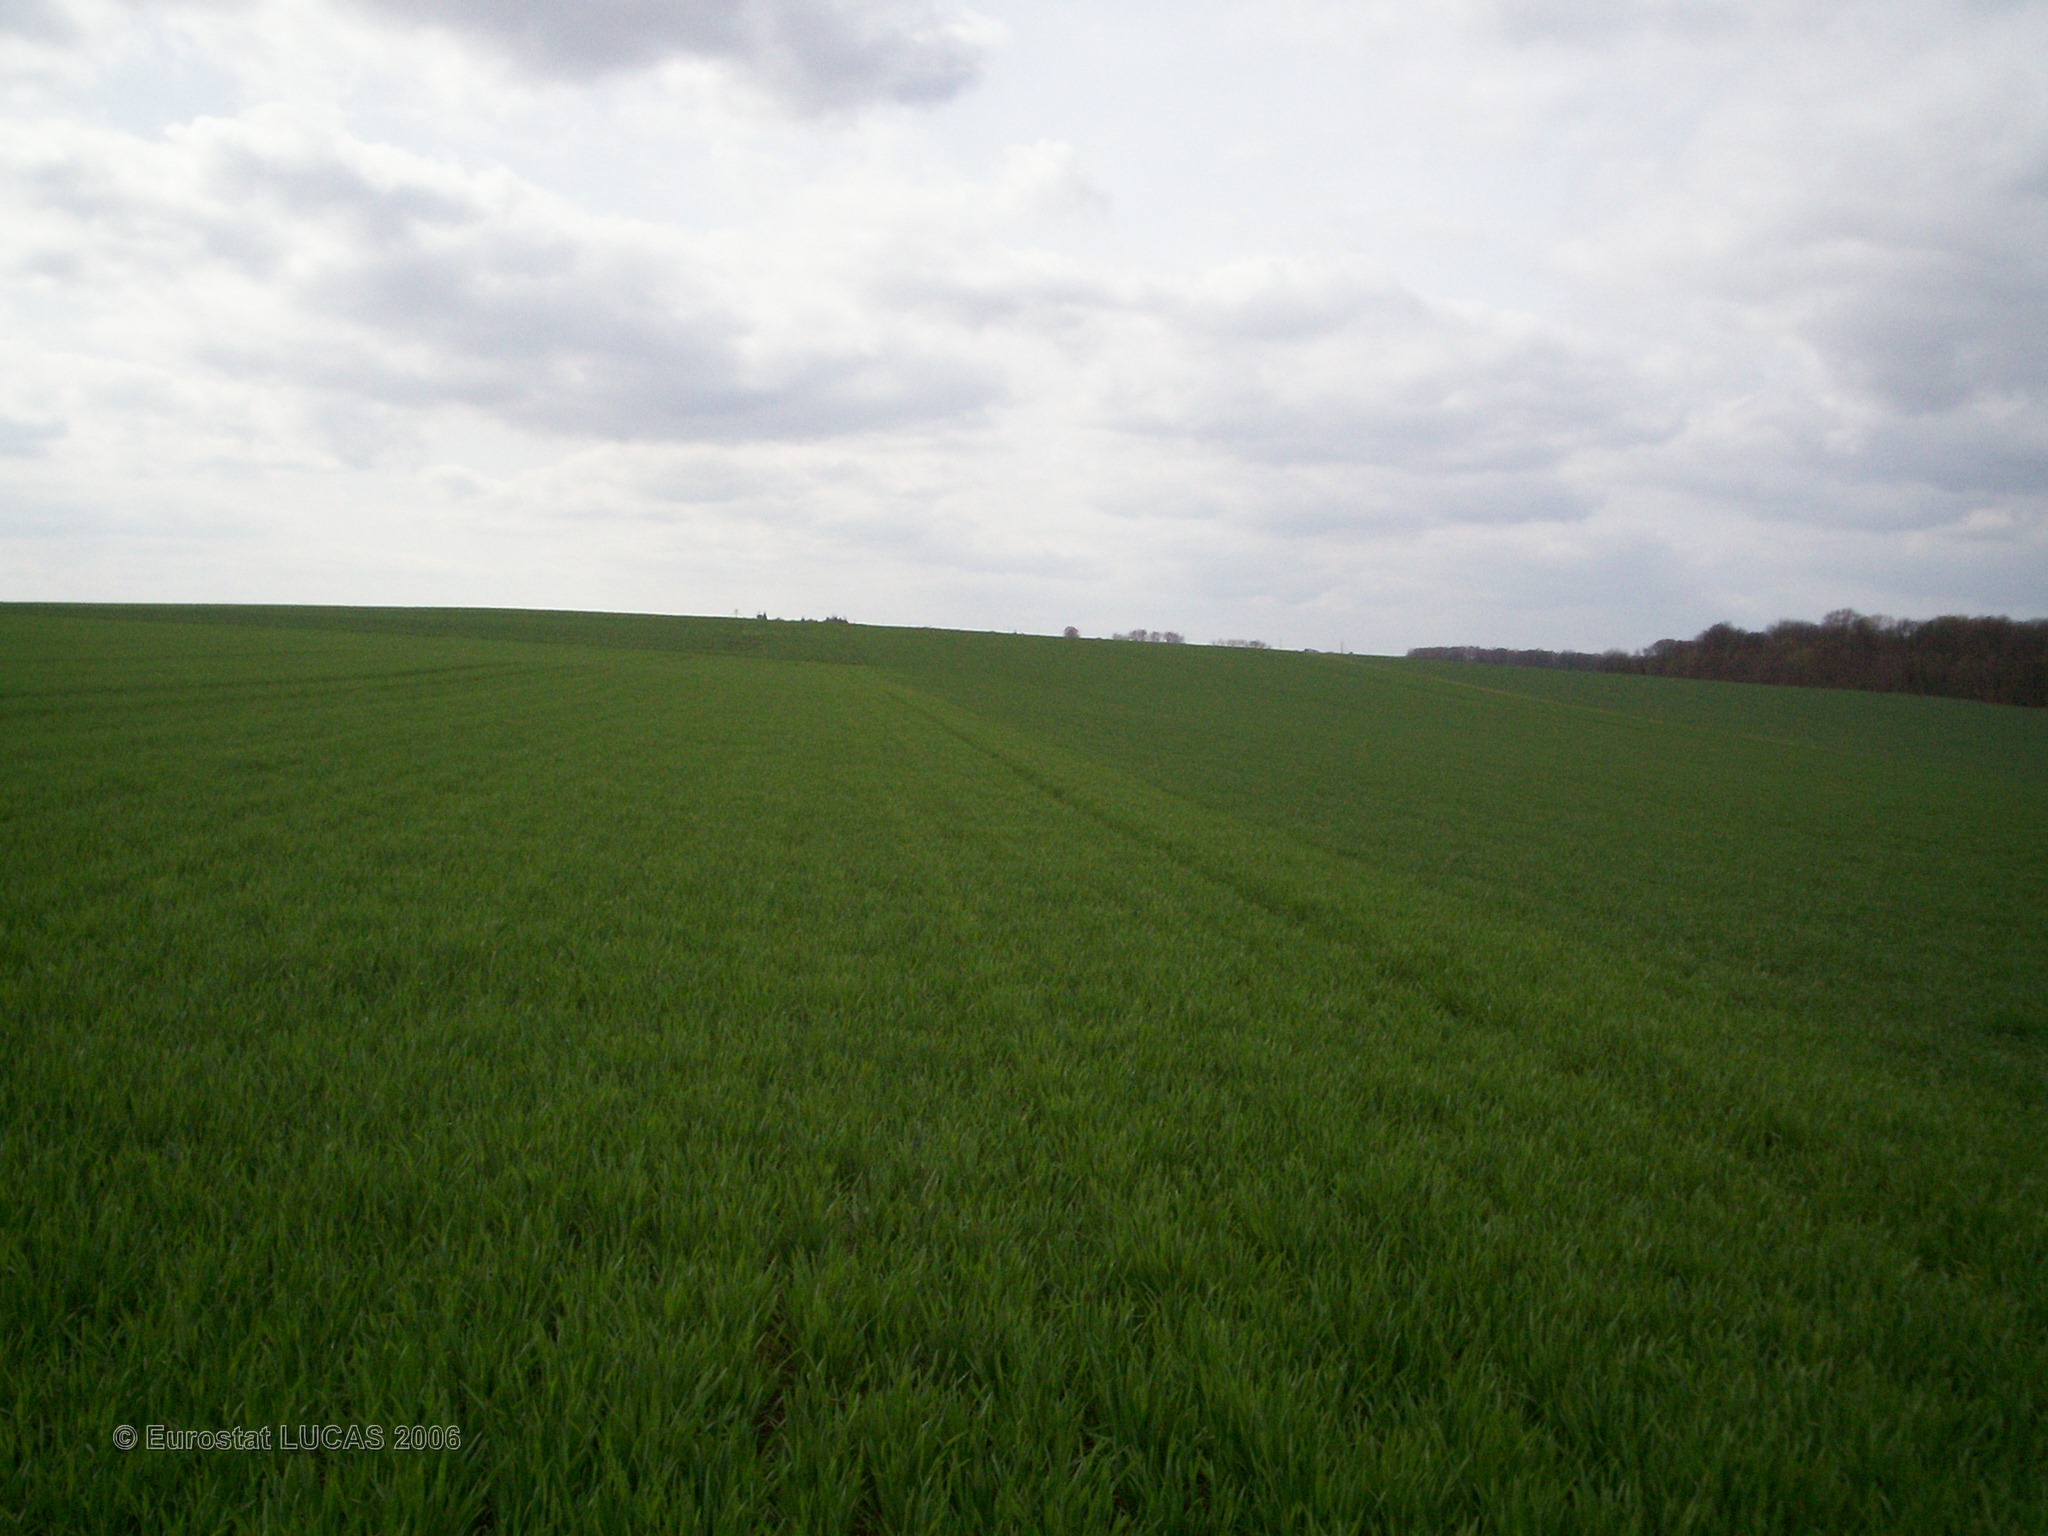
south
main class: Cropland
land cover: Common wheat
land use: Agriculture (excluding fallow land and kitchen gardens)
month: April
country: FR
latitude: 47.9181
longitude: 4.0422
